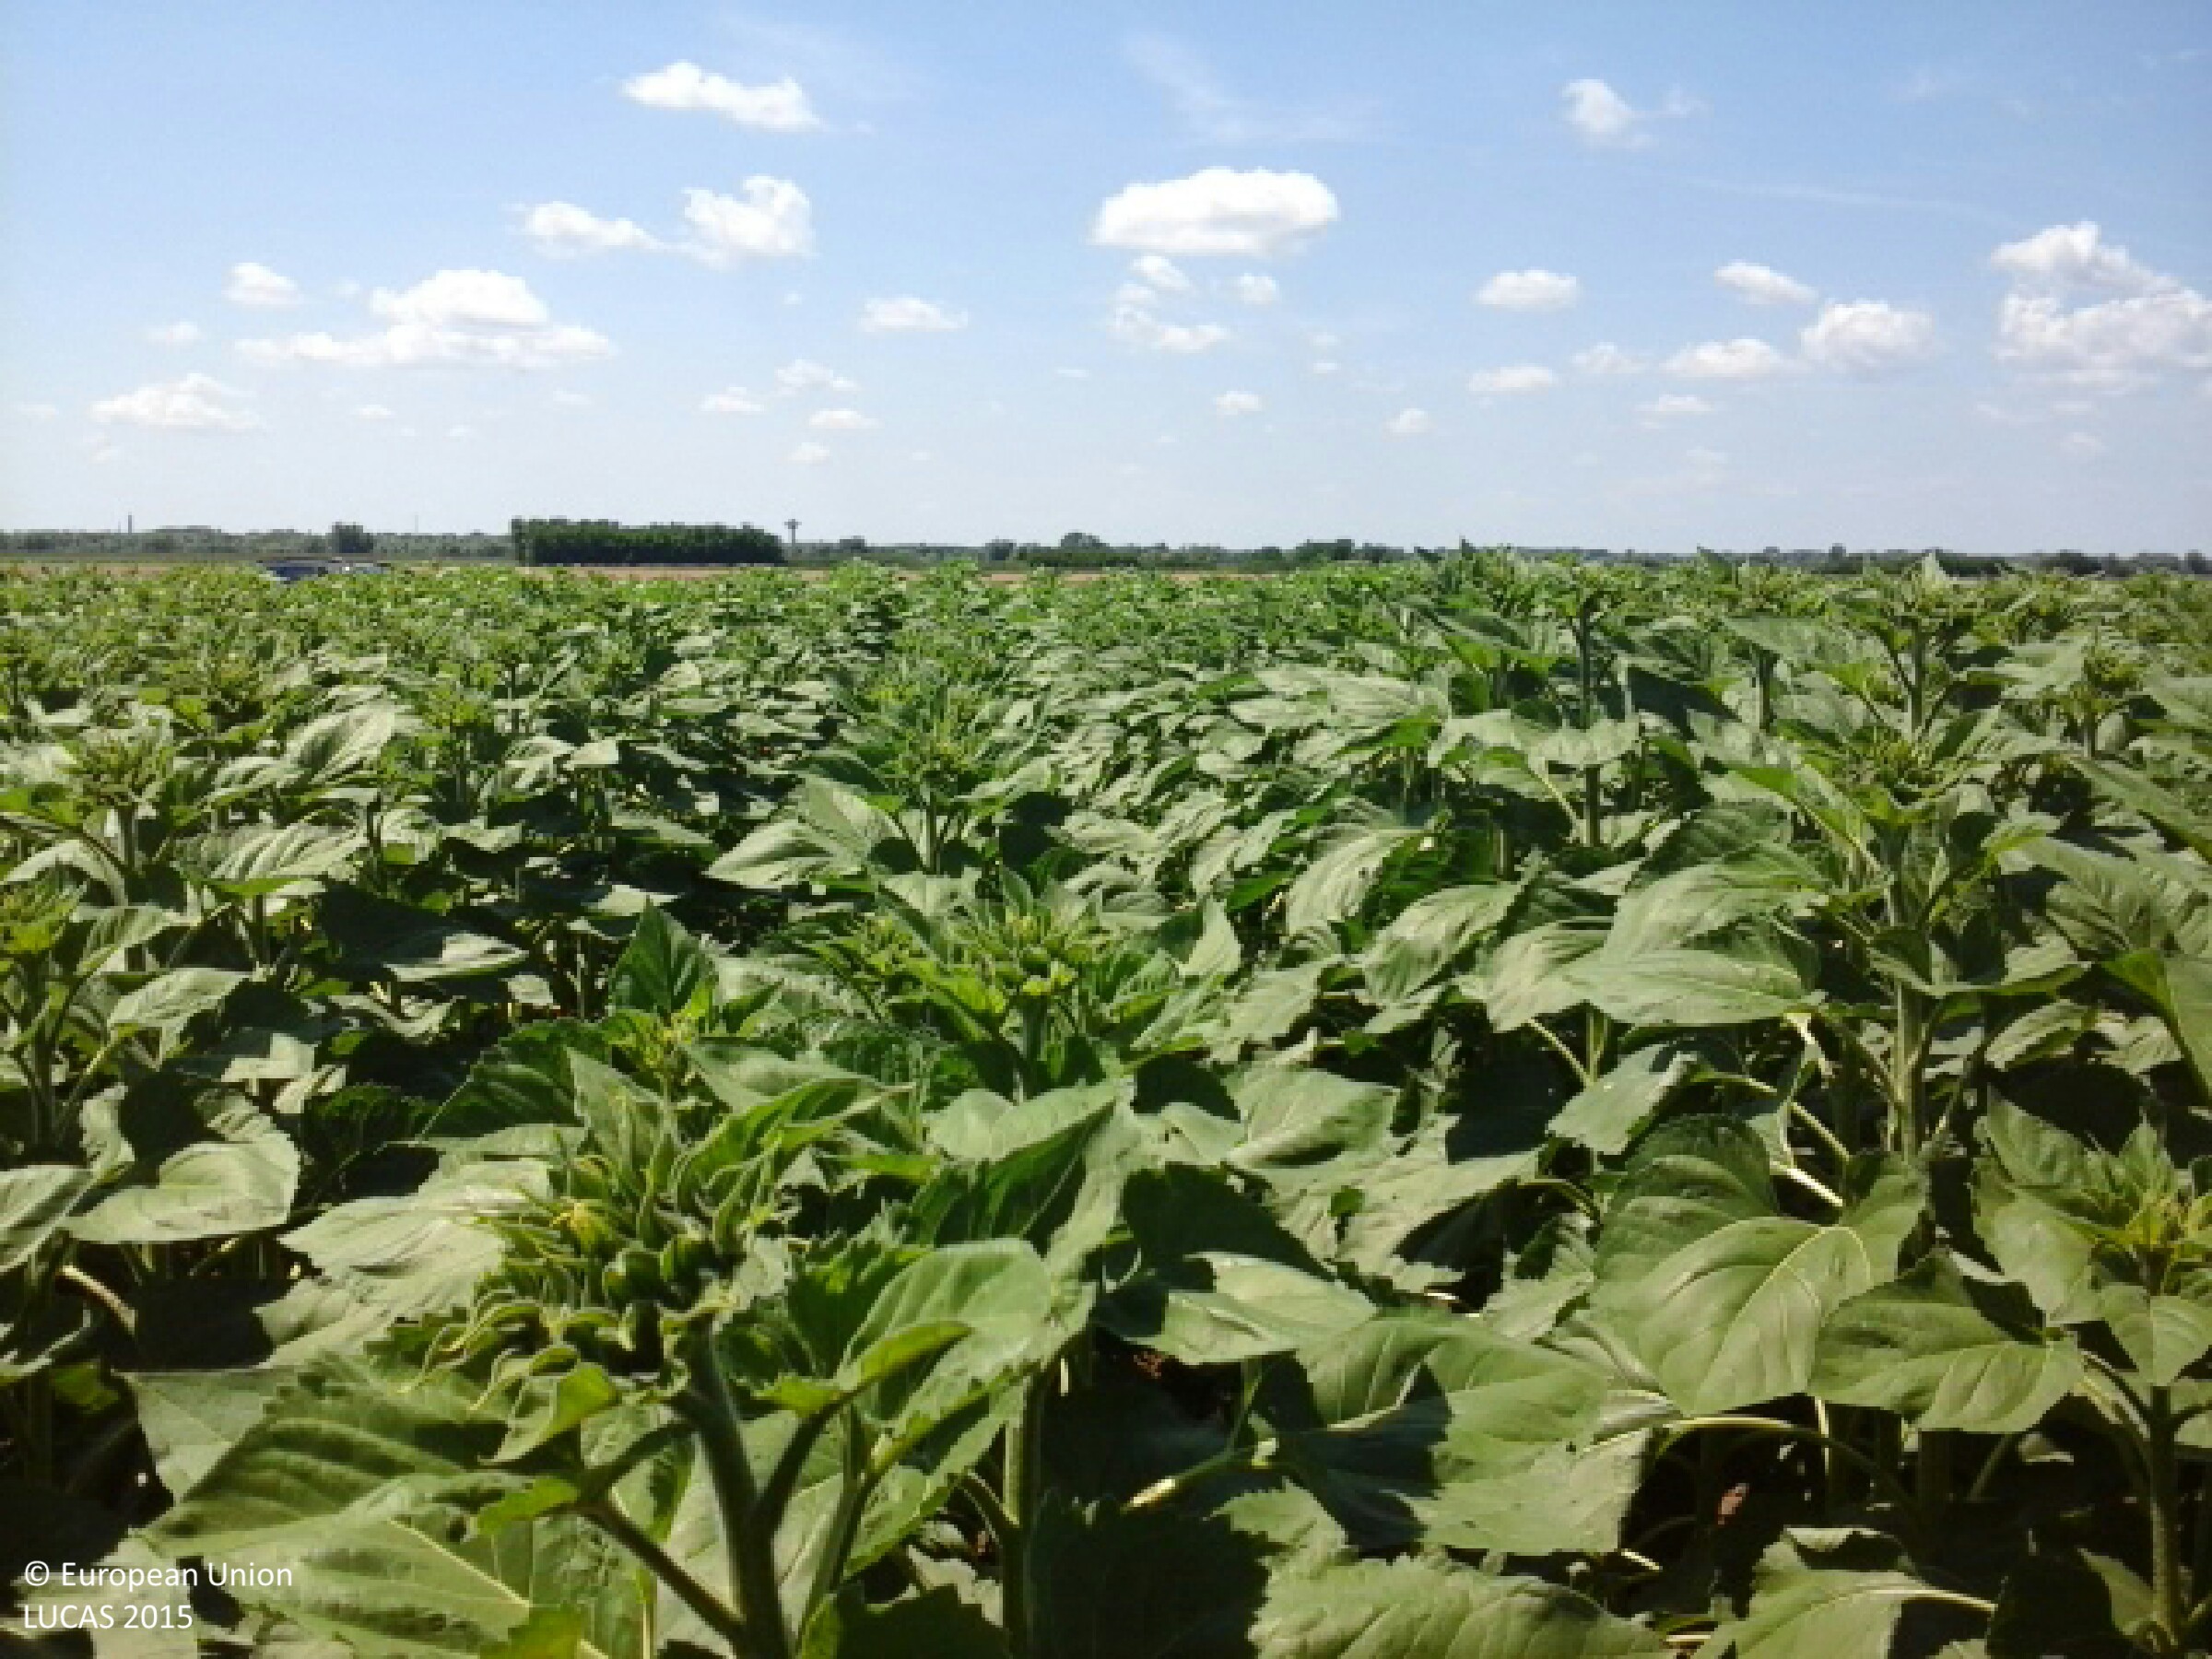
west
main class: Cropland
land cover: Sunflower
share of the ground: > 75 %
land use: Agriculture (excluding fallow land and kitchen gardens)
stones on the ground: < 10 %
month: July
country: HU
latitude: 47.9611
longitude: 22.3650
